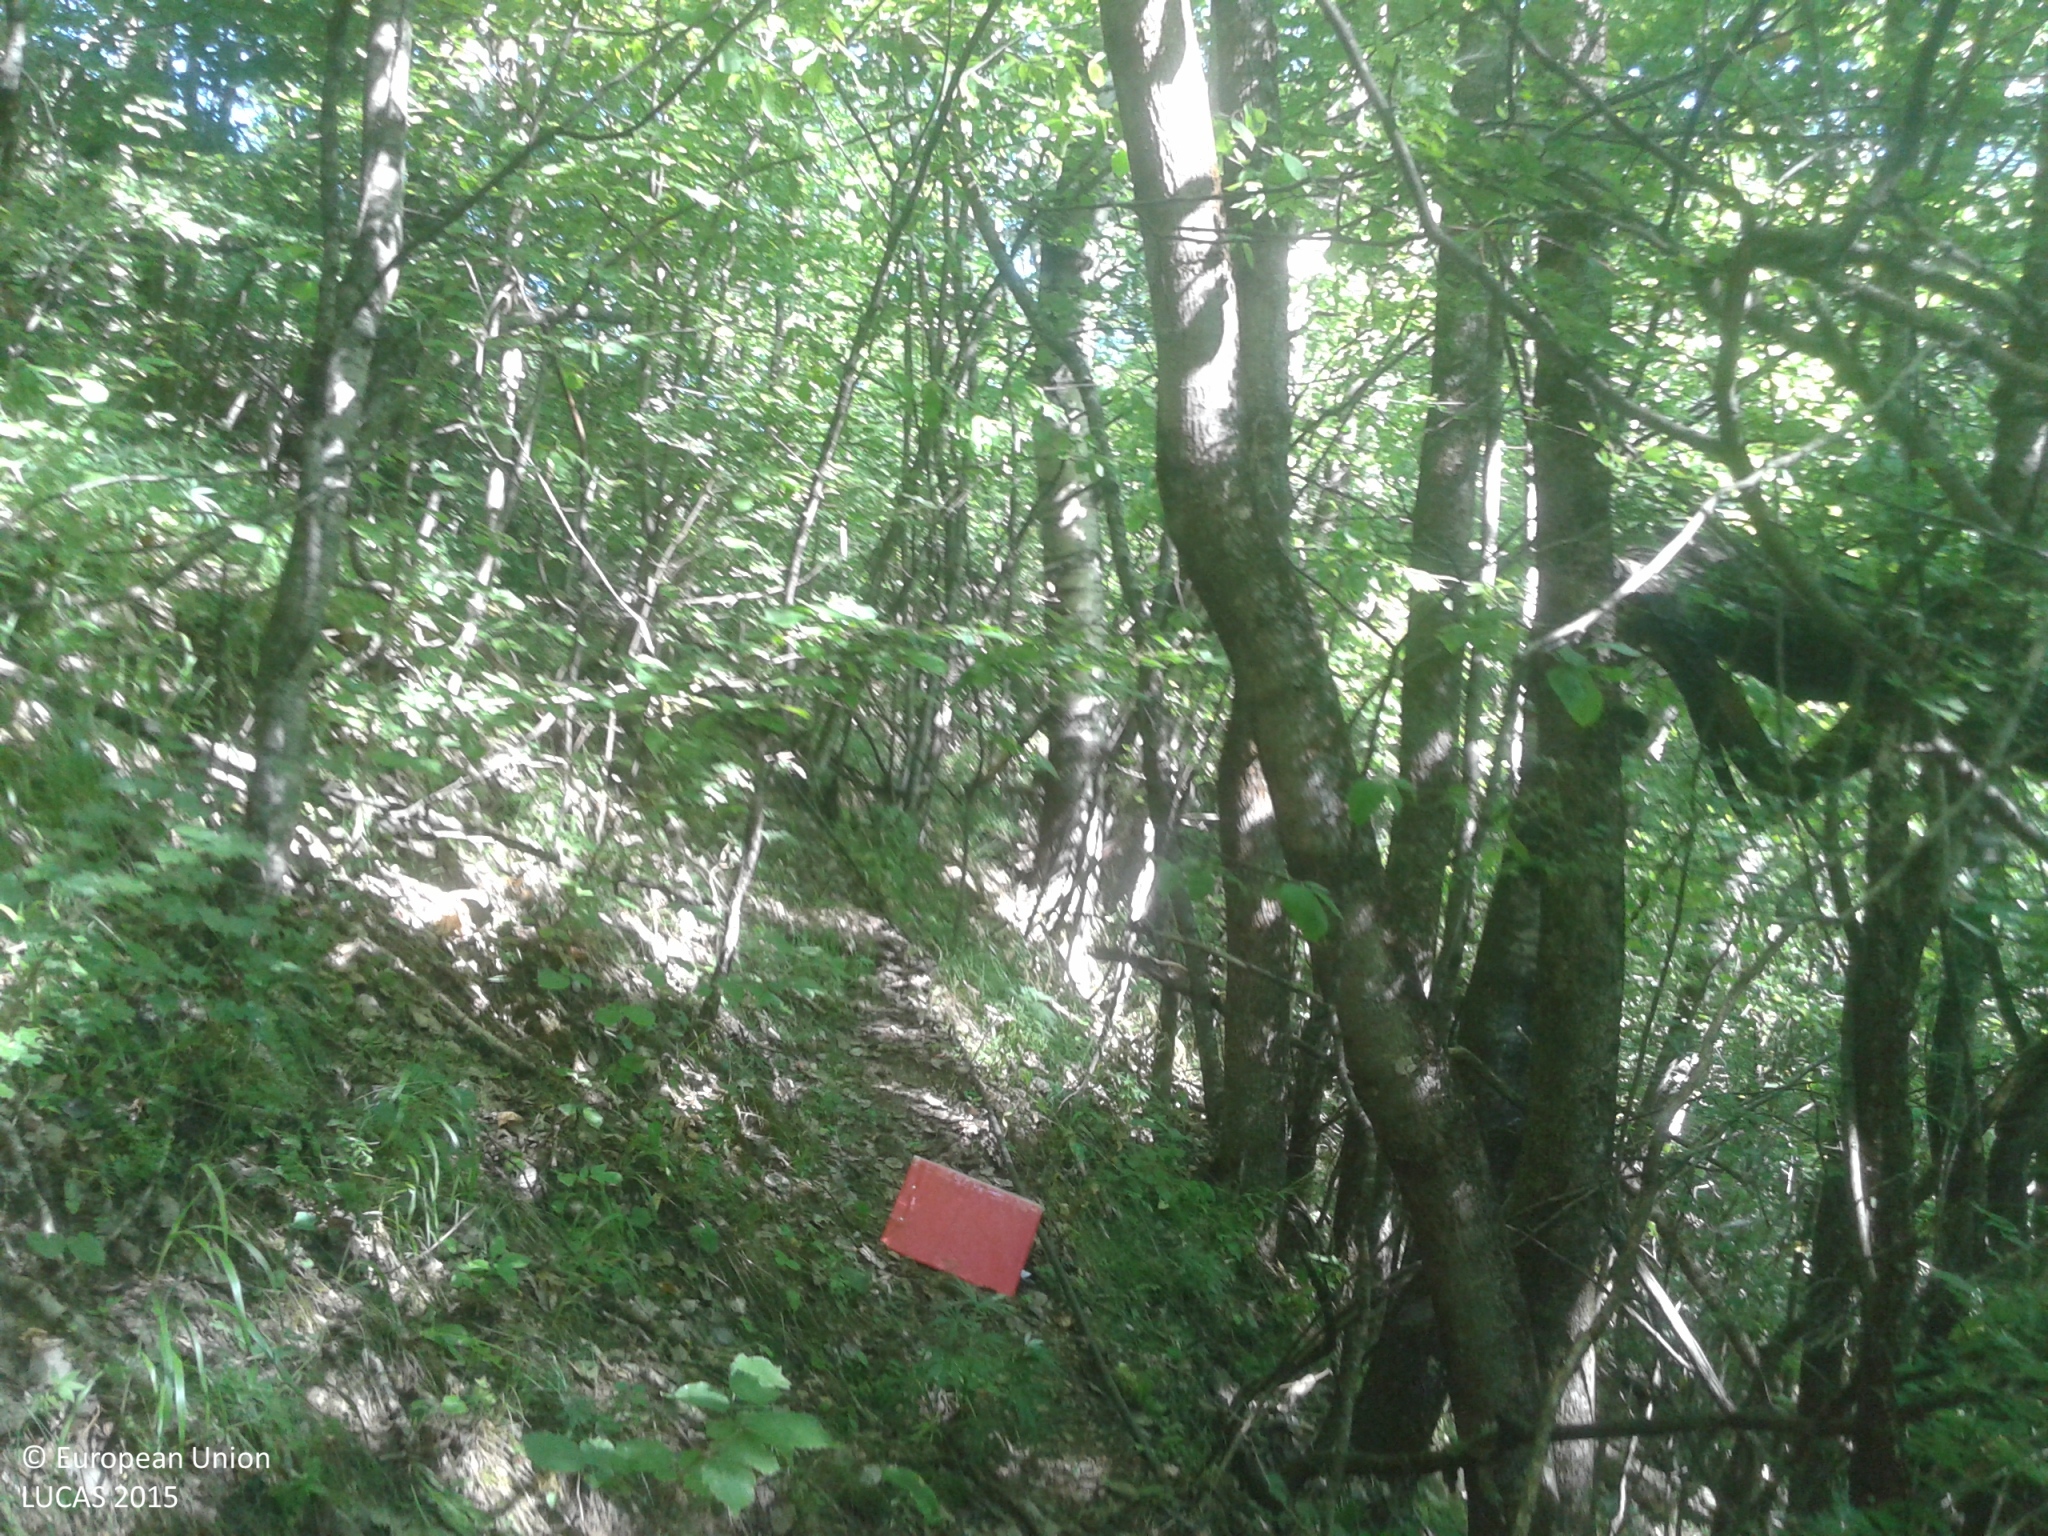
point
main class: Woodland
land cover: Broadleaved woodland
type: alpine coniferous forest
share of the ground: > 75 %
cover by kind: broadleaved forest trees 95 %, herbaceous plants 5 %
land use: Semi-natural and natural areas not in use
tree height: > 5 m
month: July
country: ES
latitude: 42.4407
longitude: 1.0725
